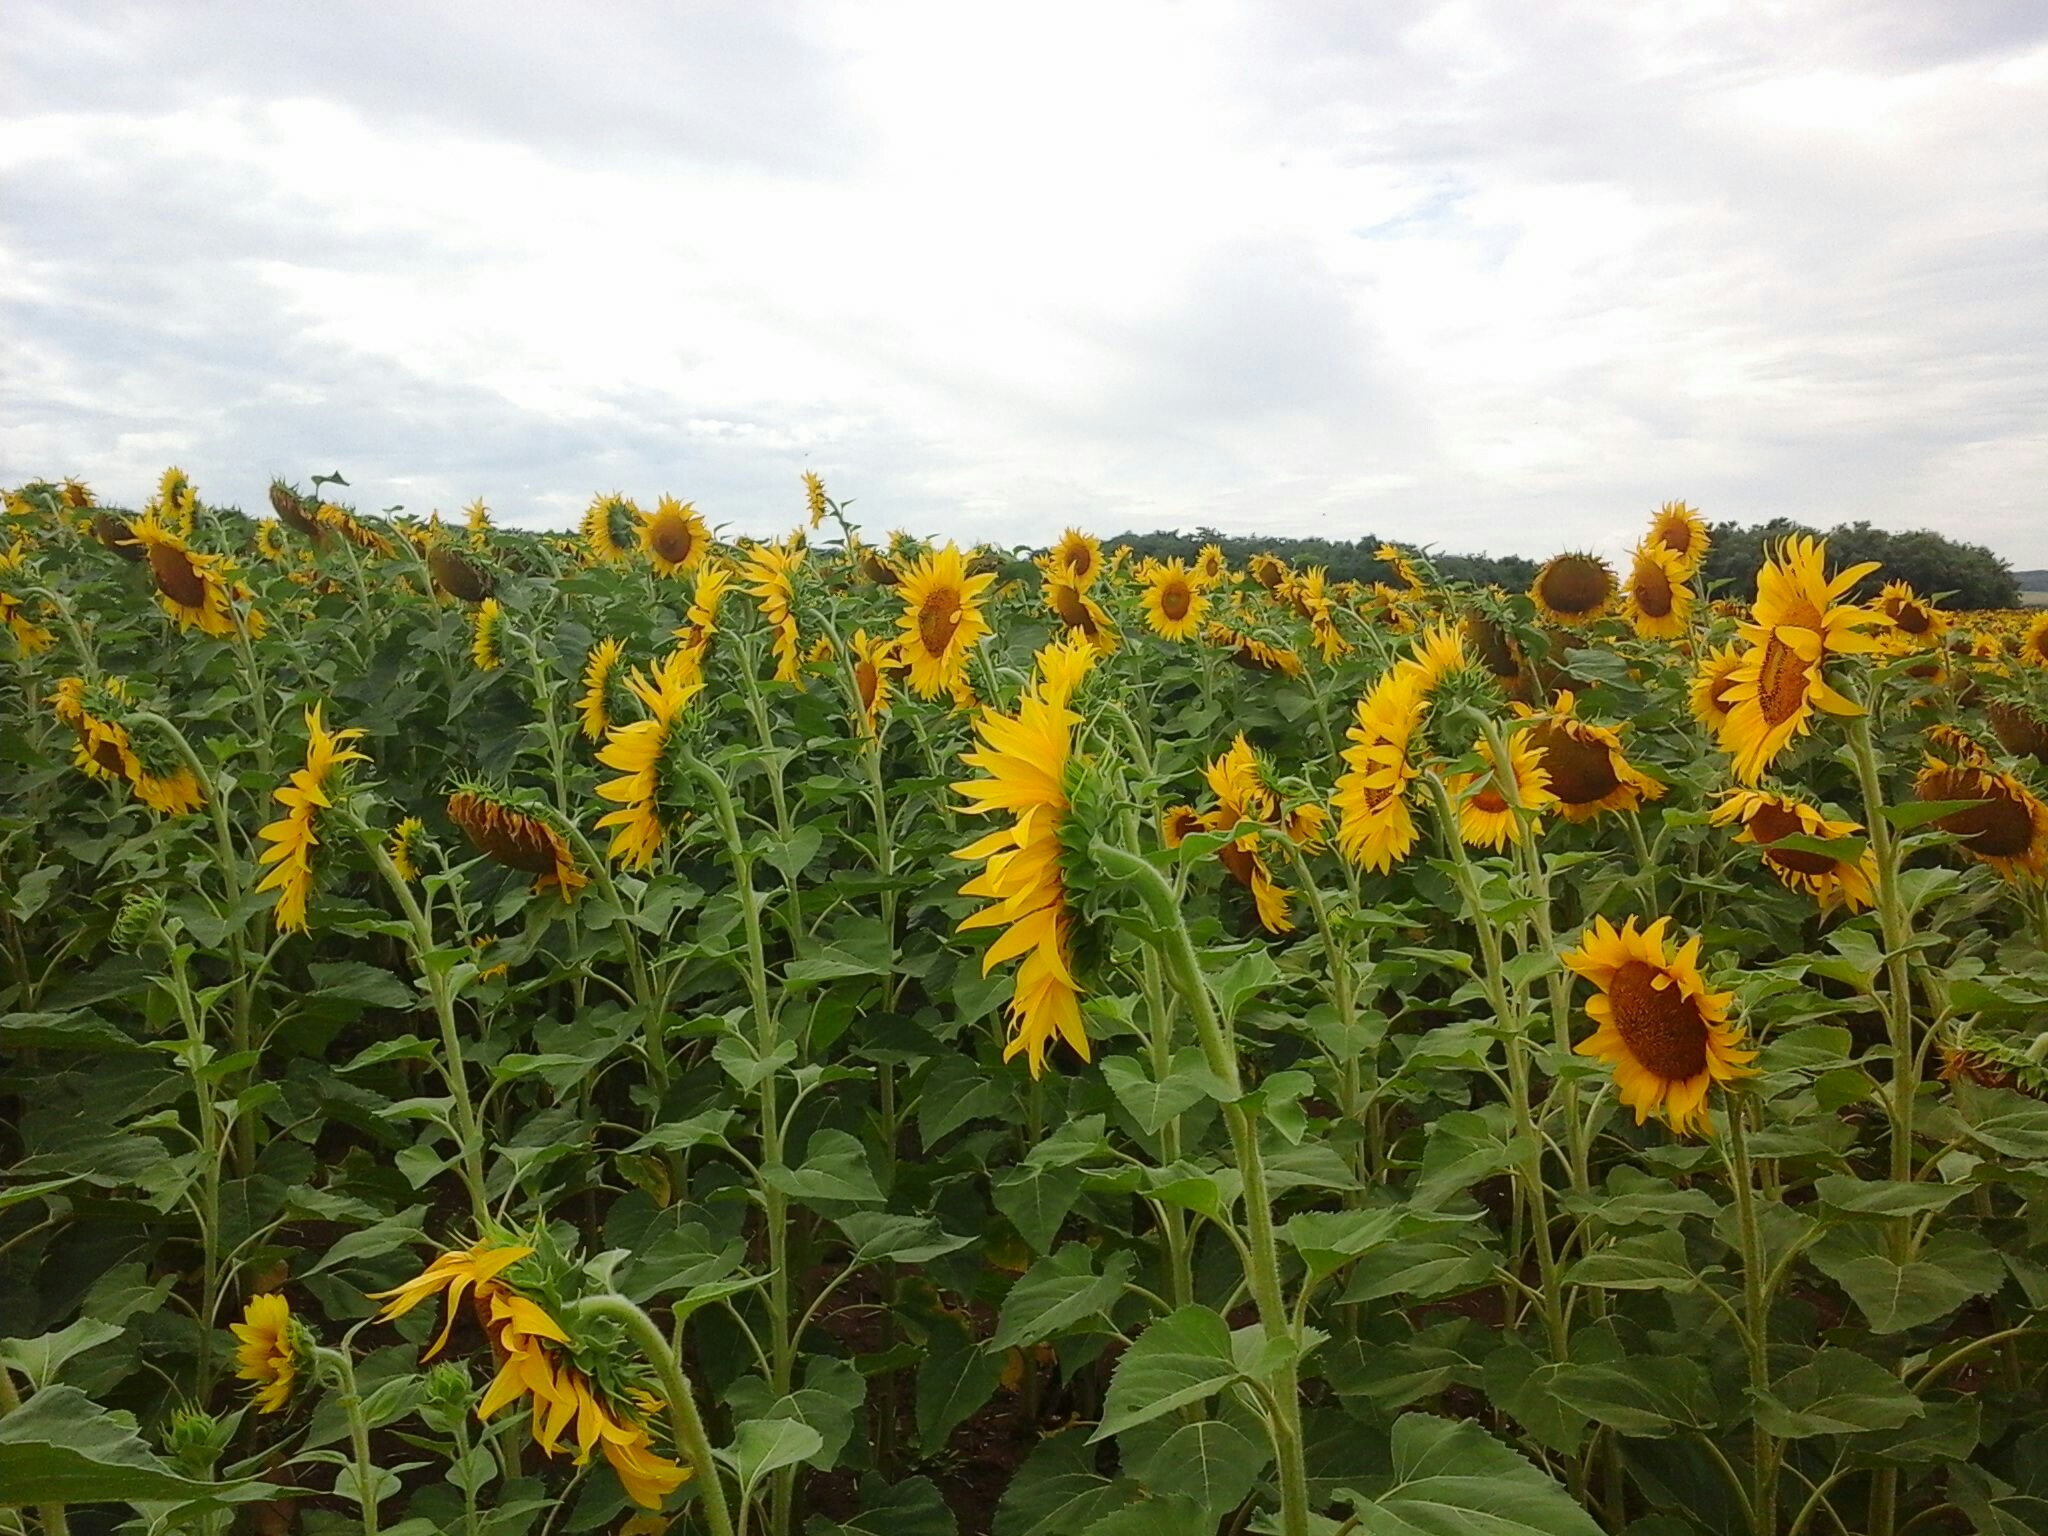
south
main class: Cropland
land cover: Sunflower
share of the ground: > 75 %
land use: Agriculture (excluding fallow land and kitchen gardens)
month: July
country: HU
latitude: 48.4407
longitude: 21.1131
